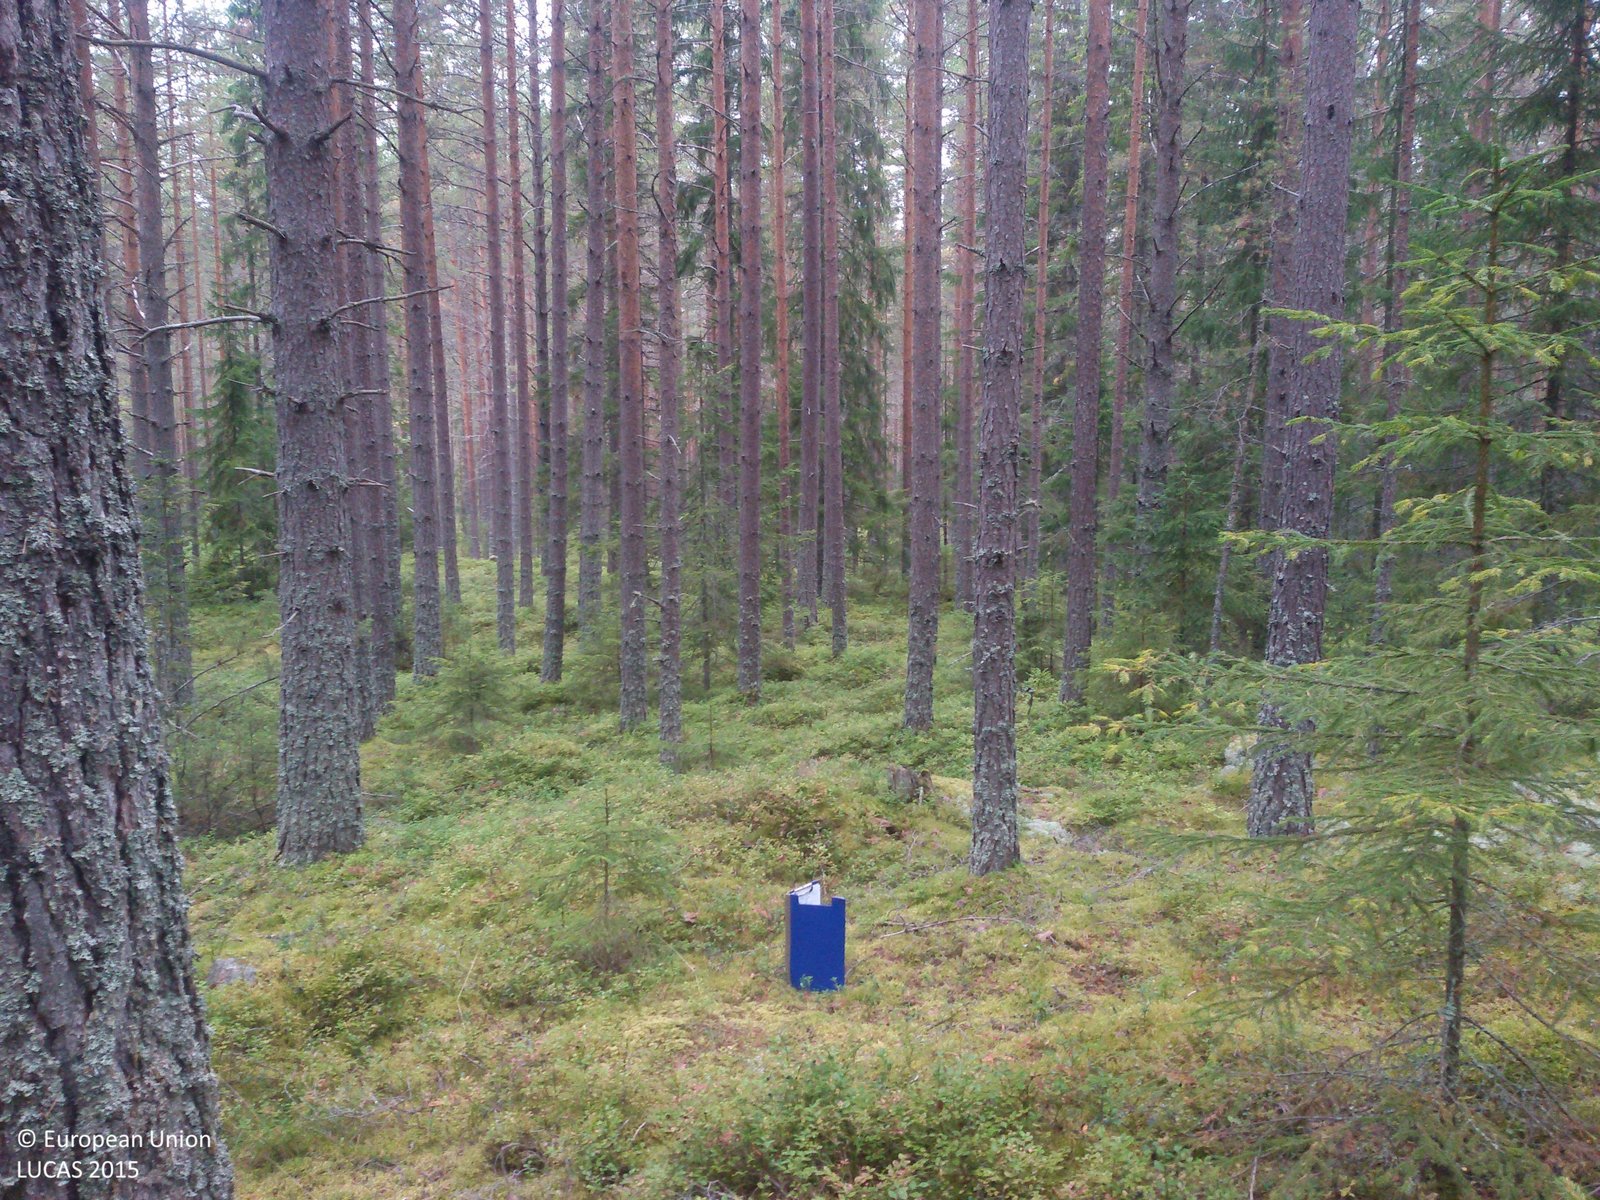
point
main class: Woodland
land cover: Pine dominated coniferous woodland
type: boreal forest
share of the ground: > 75 %
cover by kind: coniferous forest trees 75 %, shrubs 15 %, lichens and mosses 10 %
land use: Forestry
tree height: > 5 m
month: September
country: SE
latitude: 61.0709
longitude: 14.3047
